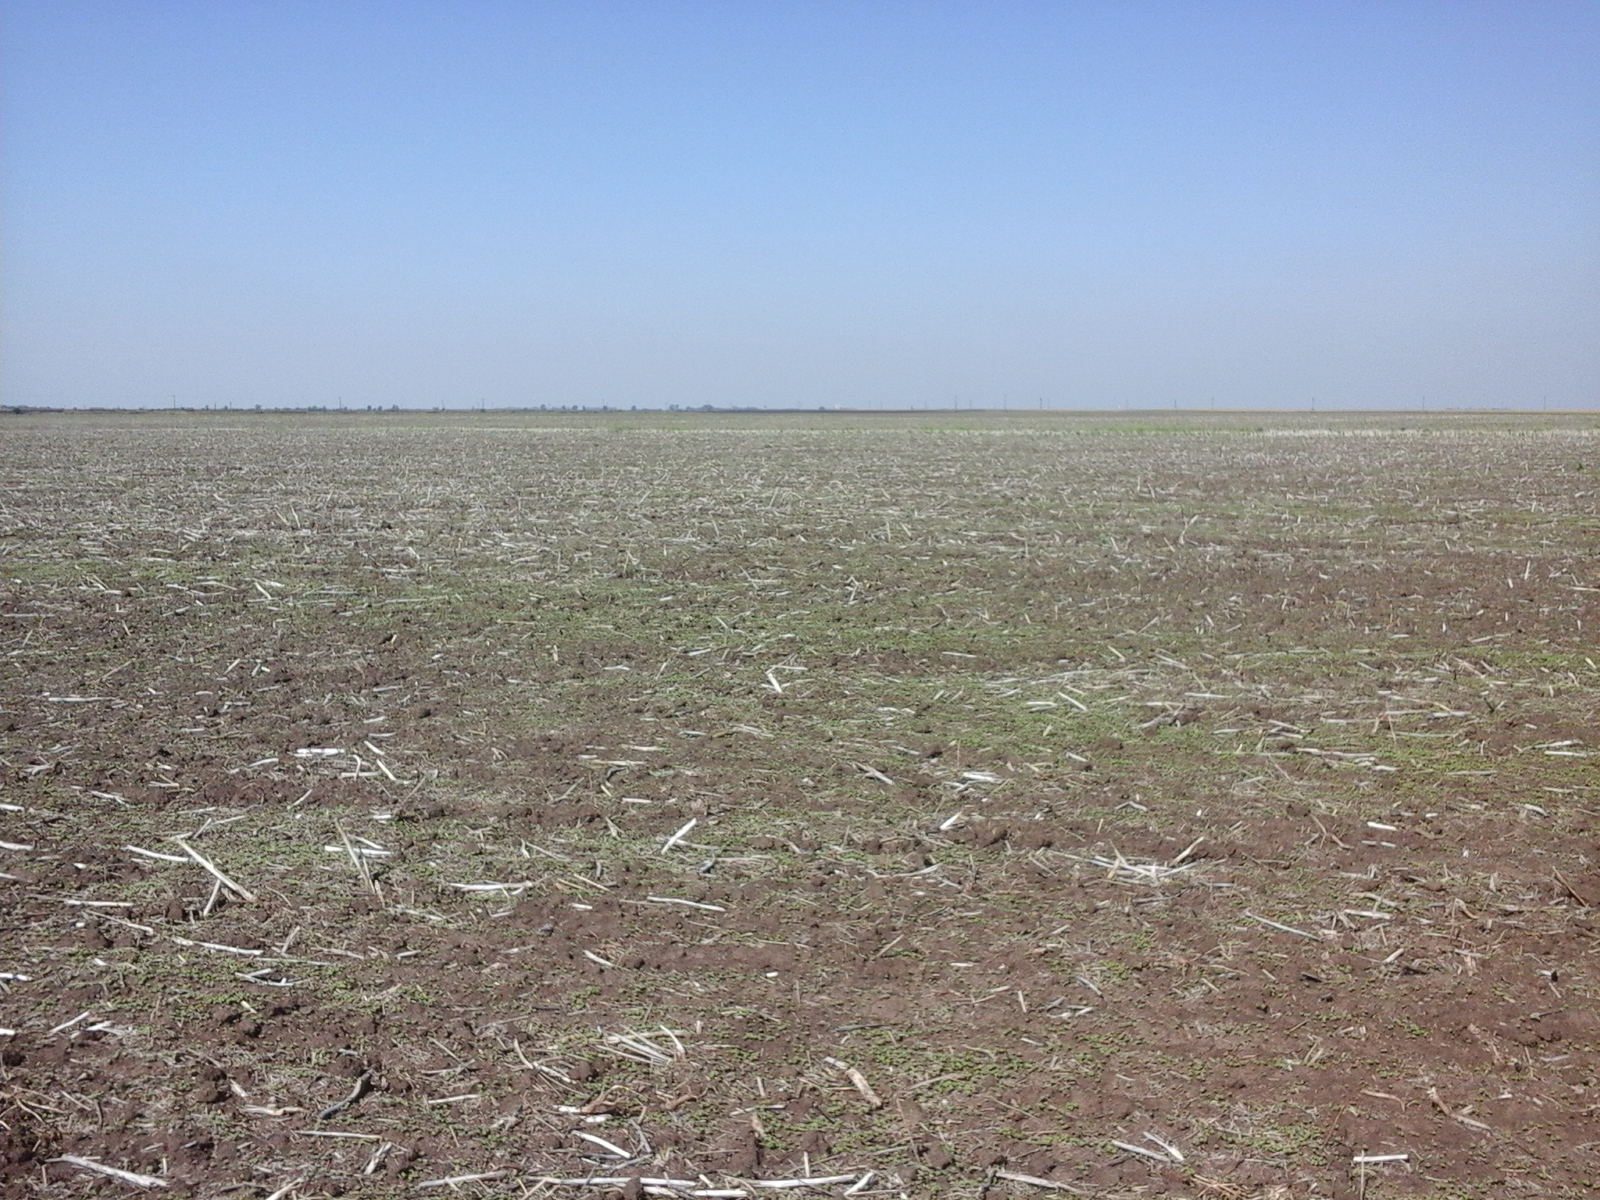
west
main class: Cropland
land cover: Rape and turnip rape
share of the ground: < 10 %
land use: Agriculture (excluding fallow land and kitchen gardens)
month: August
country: RO
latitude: 45.9120
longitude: 20.9739
